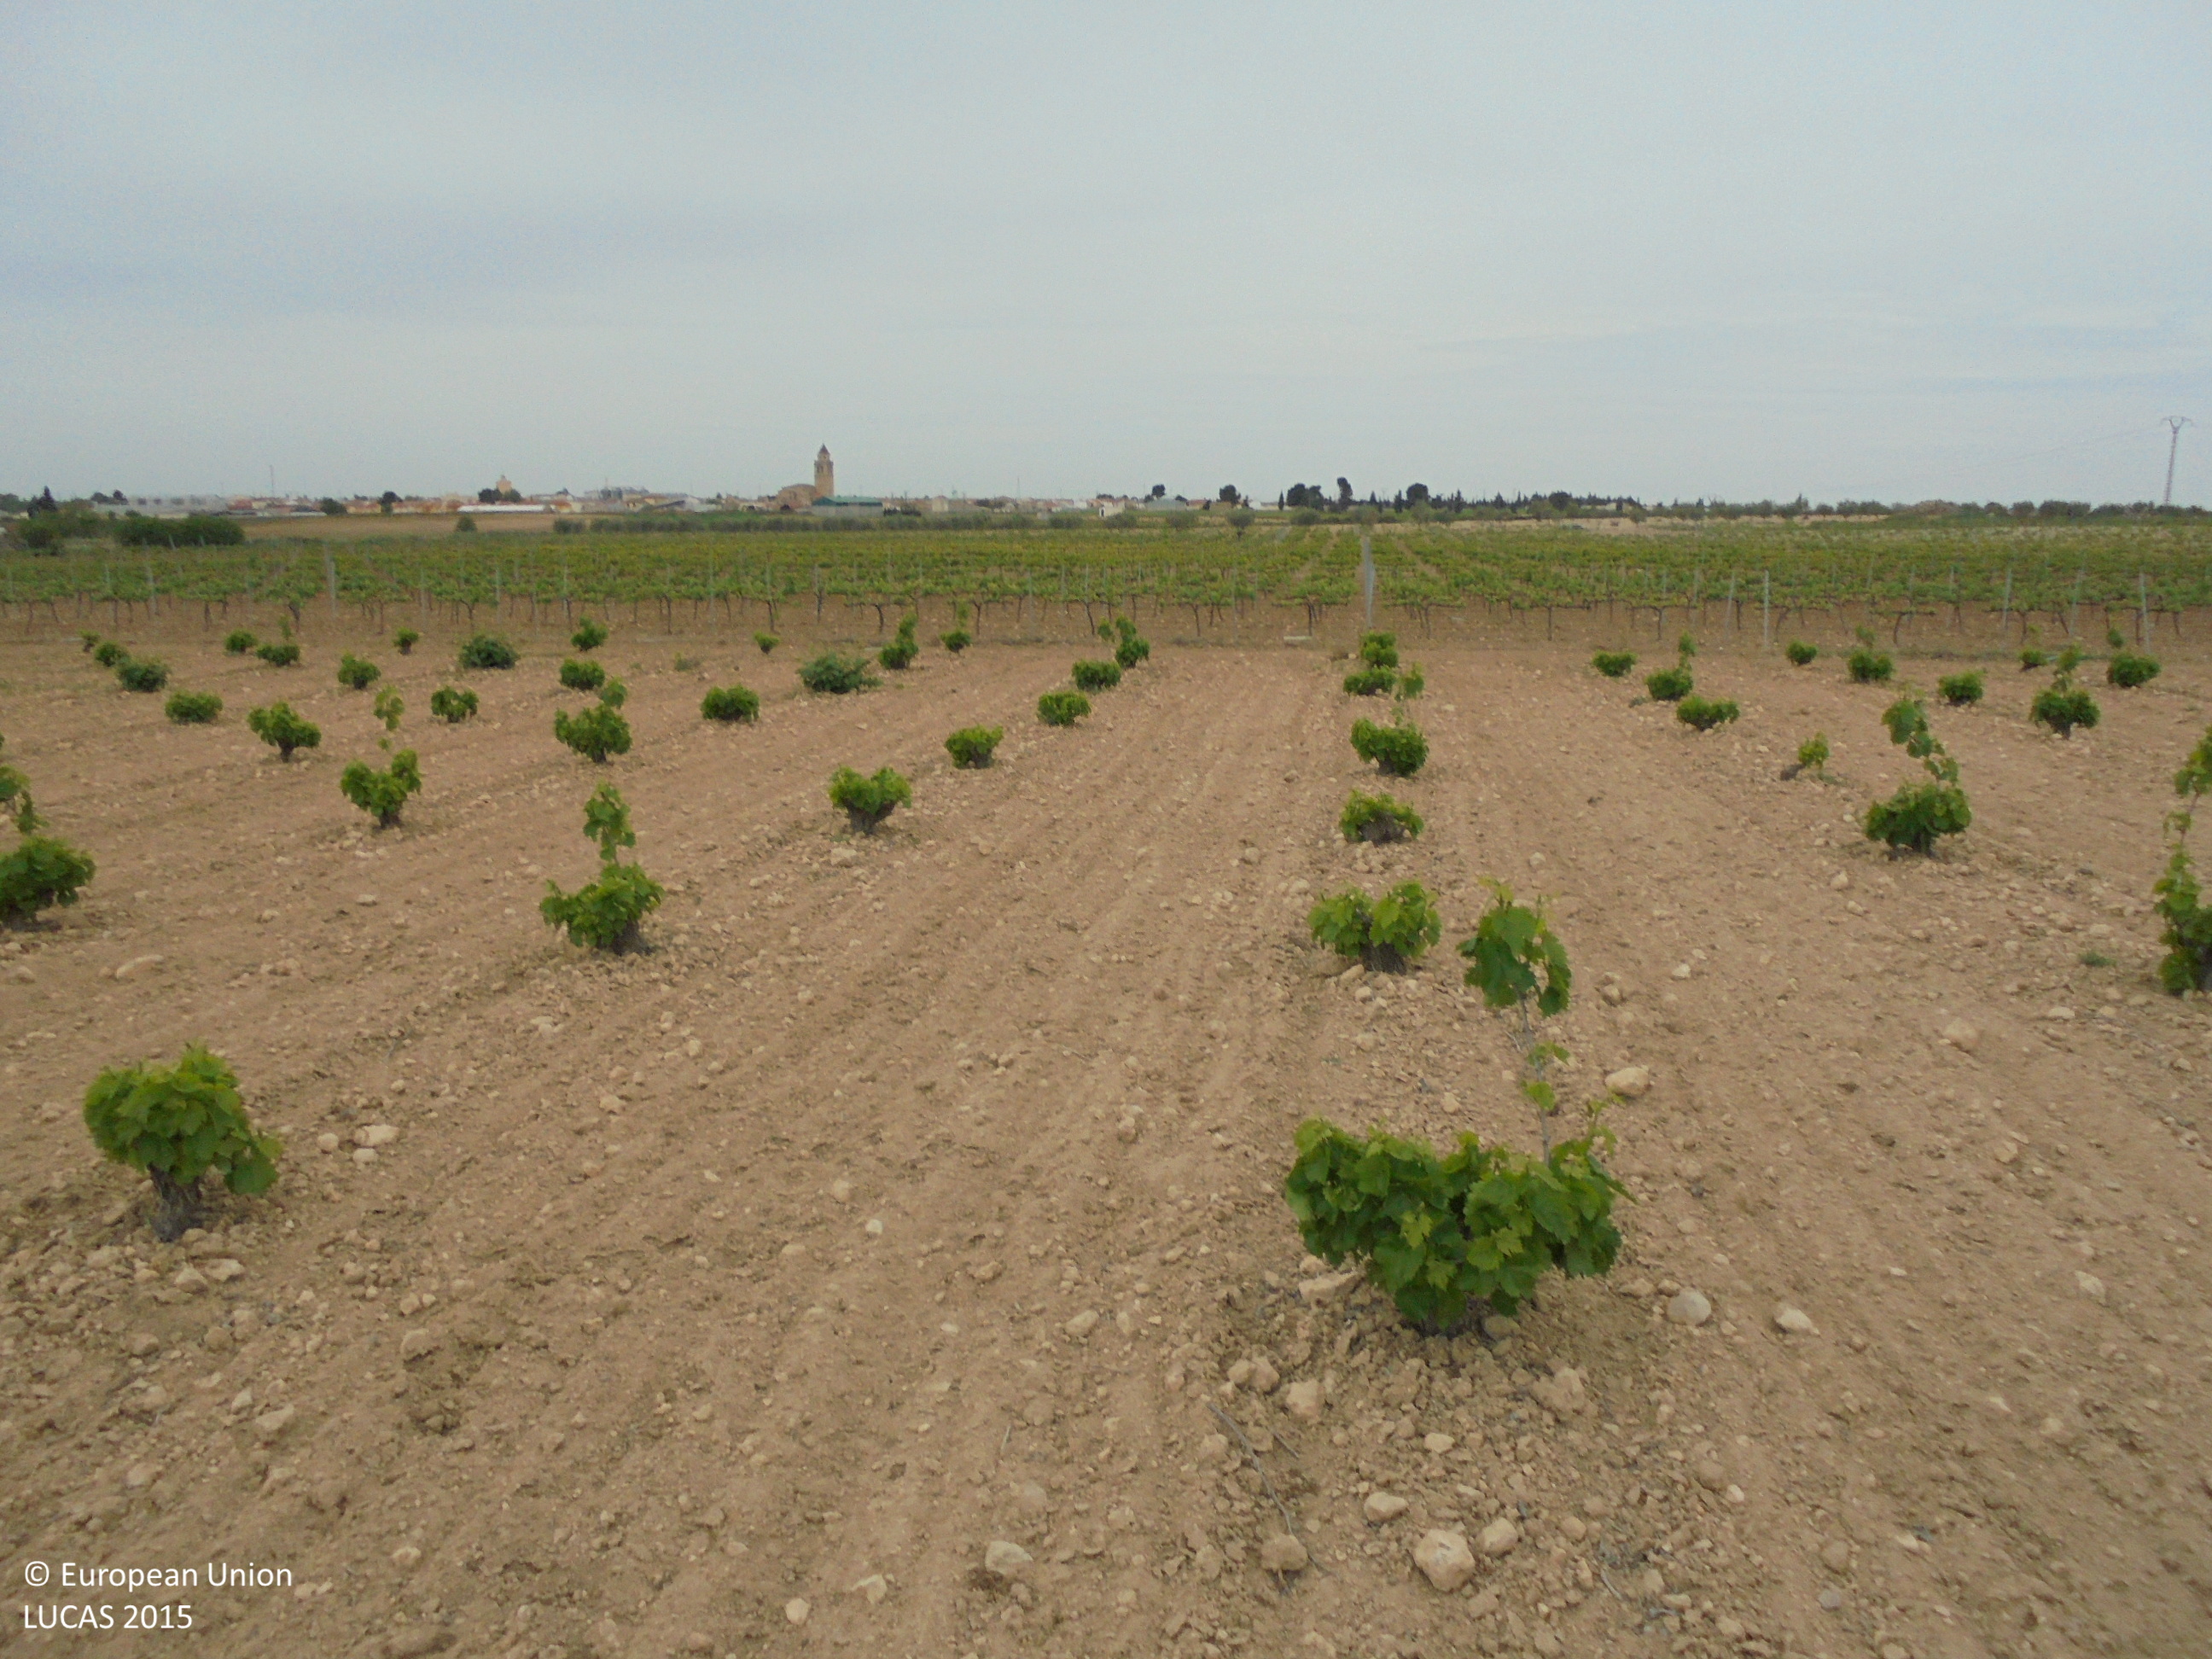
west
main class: Cropland
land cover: Vineyards
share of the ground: 10 - 25 %
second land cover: Other bare soil
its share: > 75 %
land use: Agriculture (excluding fallow land and kitchen gardens)
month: May
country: ES
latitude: 39.2162
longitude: -1.7115
